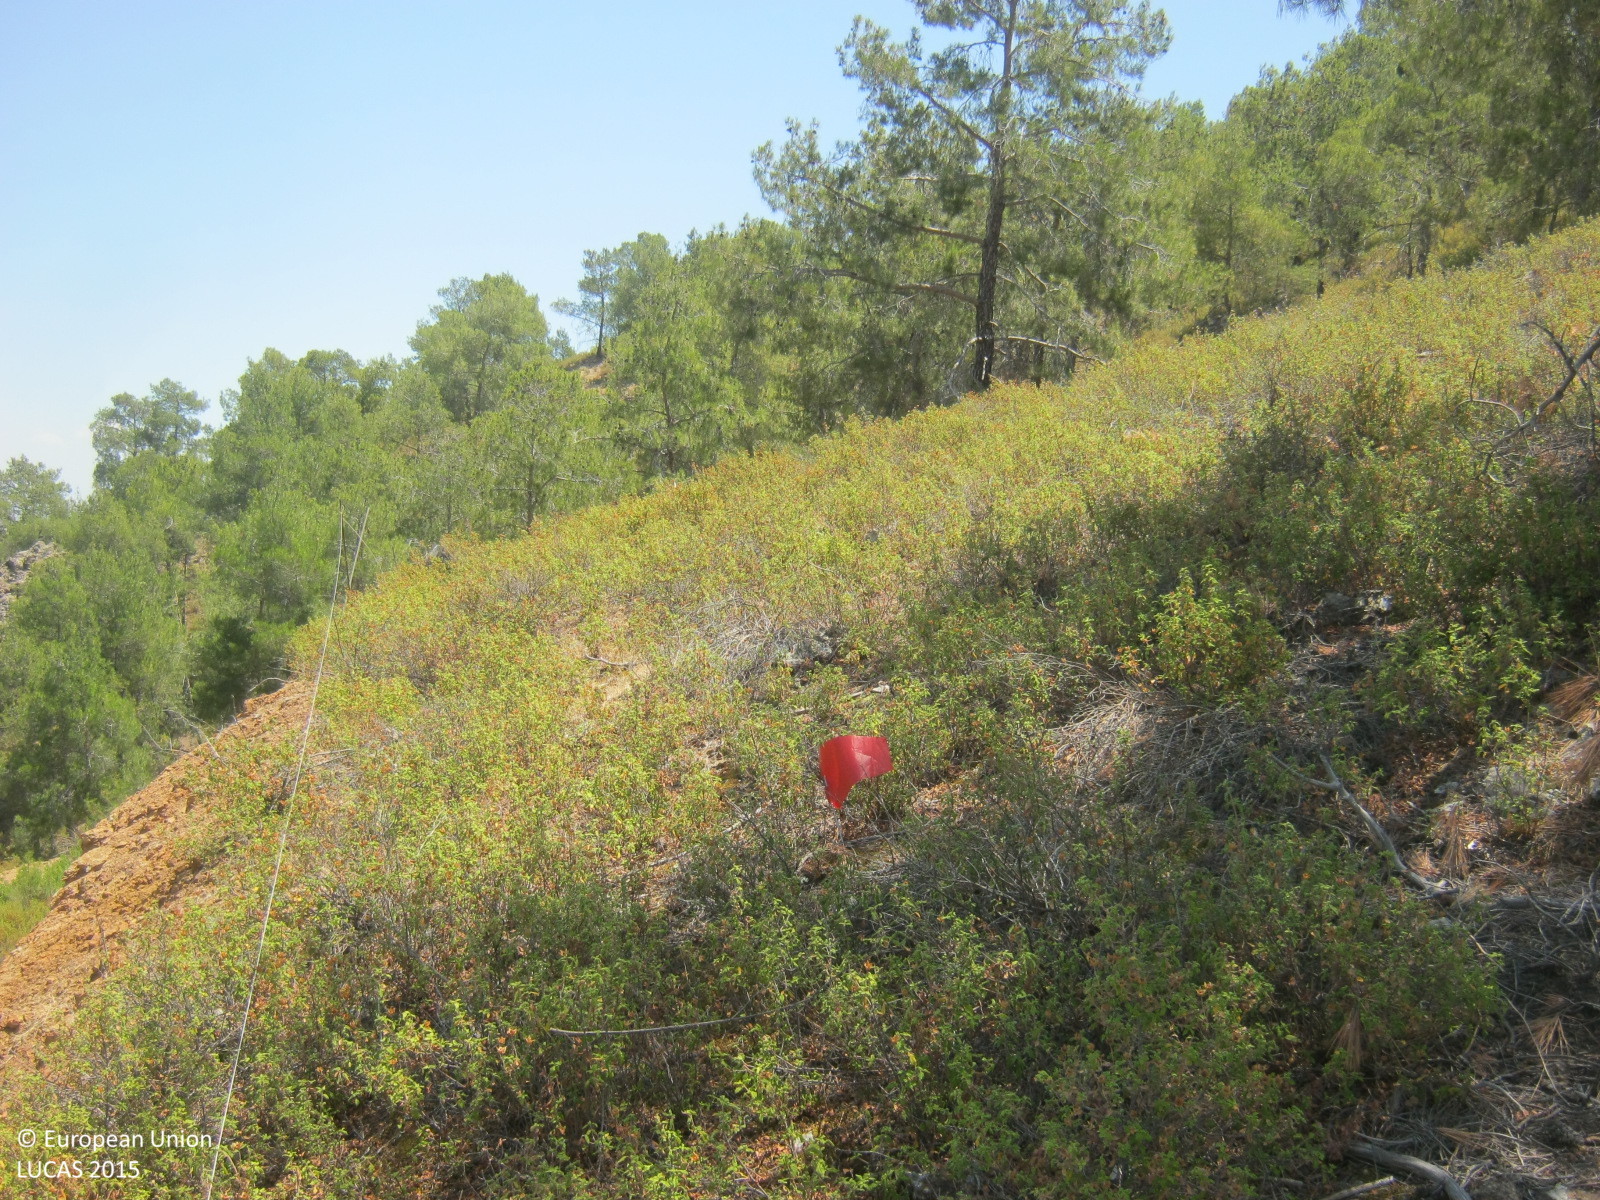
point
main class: Woodland
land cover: Pine dominated coniferous woodland
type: coniferous forest of the mediterranean region
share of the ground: 25 - 50 %
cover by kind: shrubs 55 %, coniferous forest trees 30 %, unconsolidated bare surface 10 %, consolidated bare surface 5 %
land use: Forestry
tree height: > 5 m
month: June
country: CY
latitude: 34.9979
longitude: 33.1557
